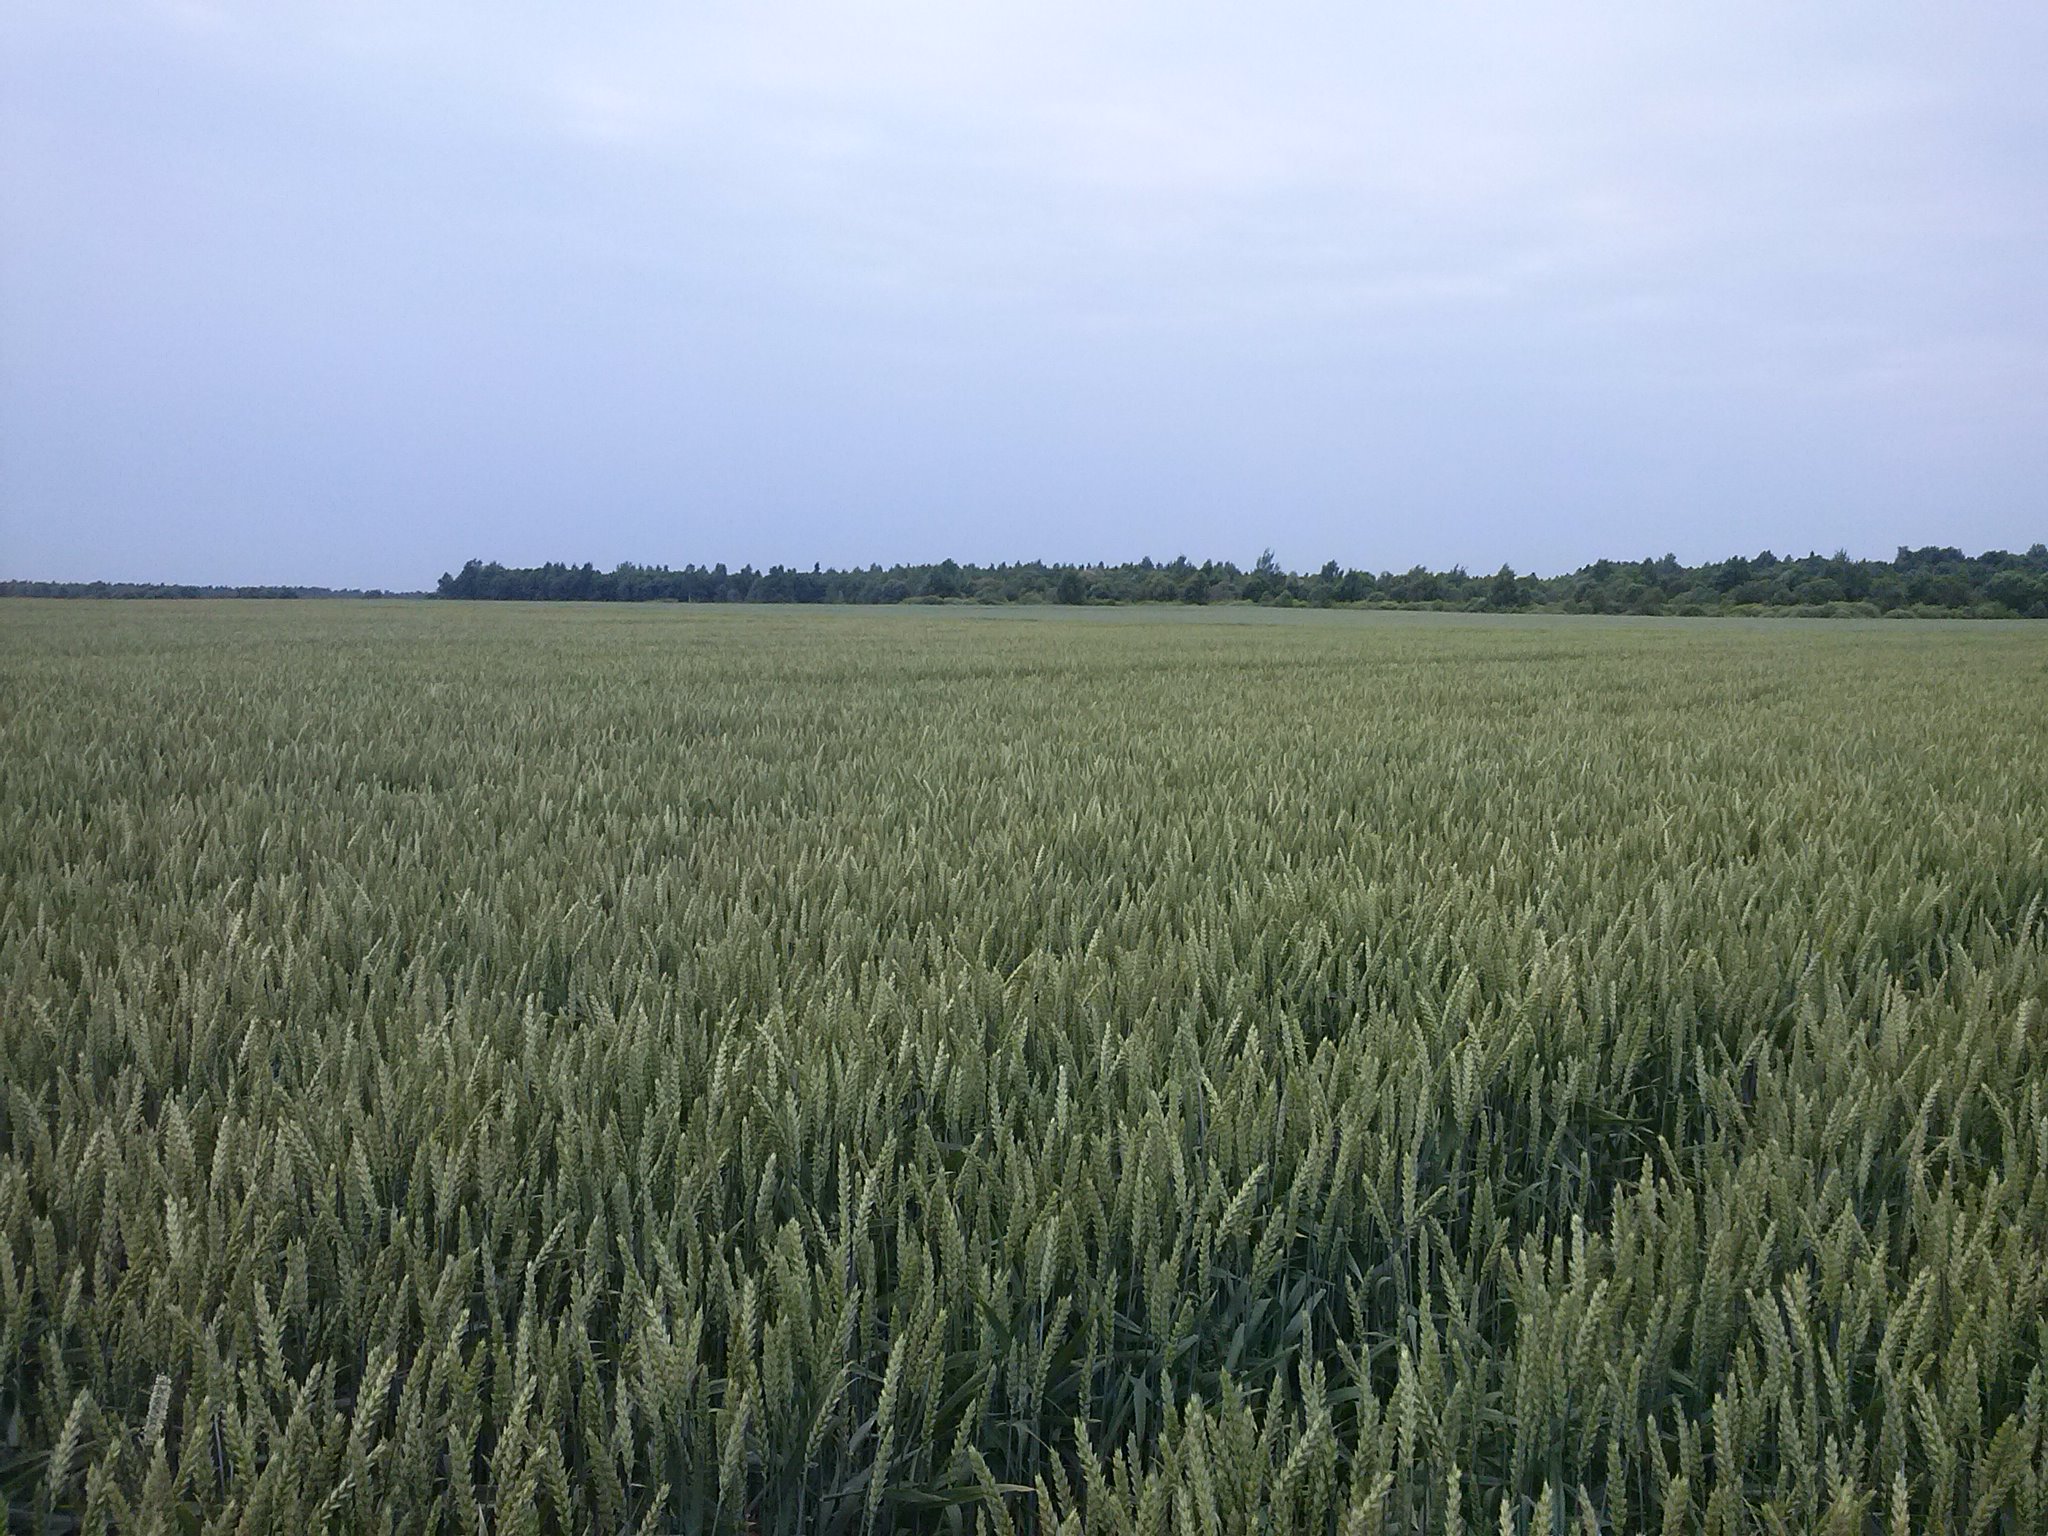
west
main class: Cropland
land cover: Common wheat
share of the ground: > 75 %
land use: Agriculture (excluding fallow land and kitchen gardens)
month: July
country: LV
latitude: 56.7871
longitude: 27.4456
